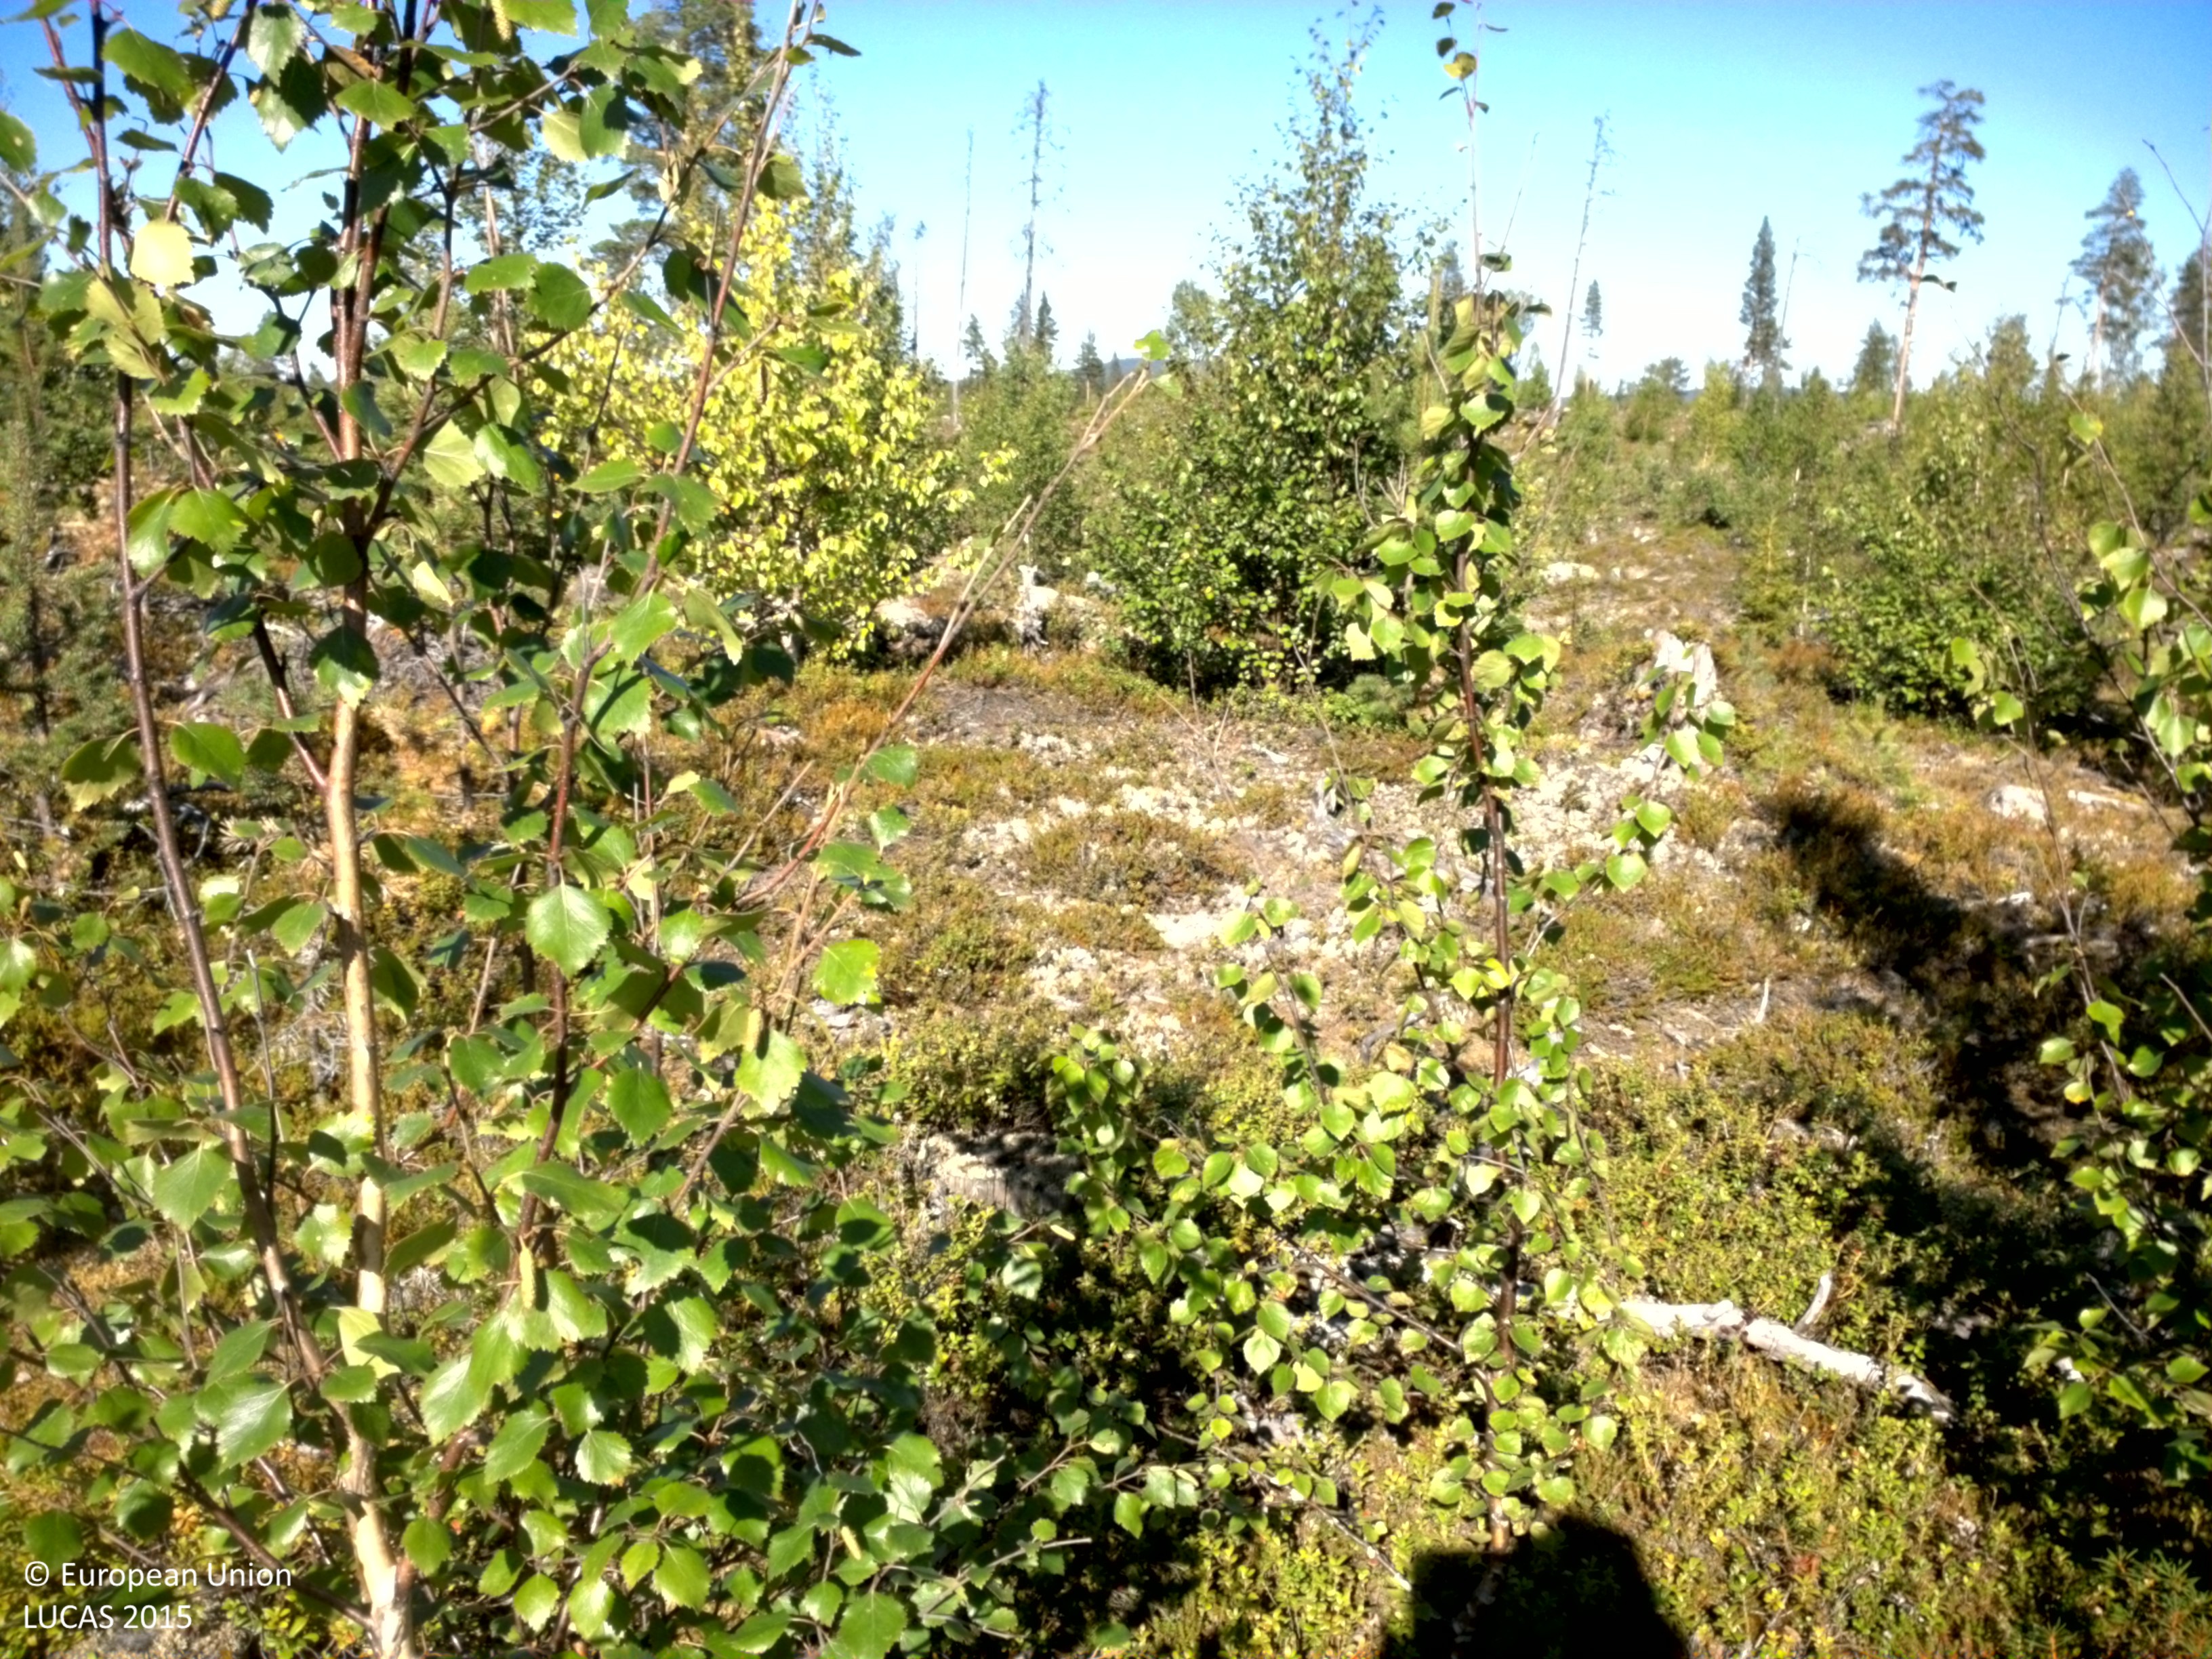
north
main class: Woodland
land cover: Pine dominated mixed woodland
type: boreal forest
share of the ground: 25 - 50 %
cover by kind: shrubs 55 %, broadleaved forest trees 20 %, coniferous forest trees 10 %, lichens and mosses 10 %, consolidated bare surface 5 %
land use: Forestry
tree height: < 5 m
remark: Clear cut
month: August
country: SE
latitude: 66.8101
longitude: 18.8464
